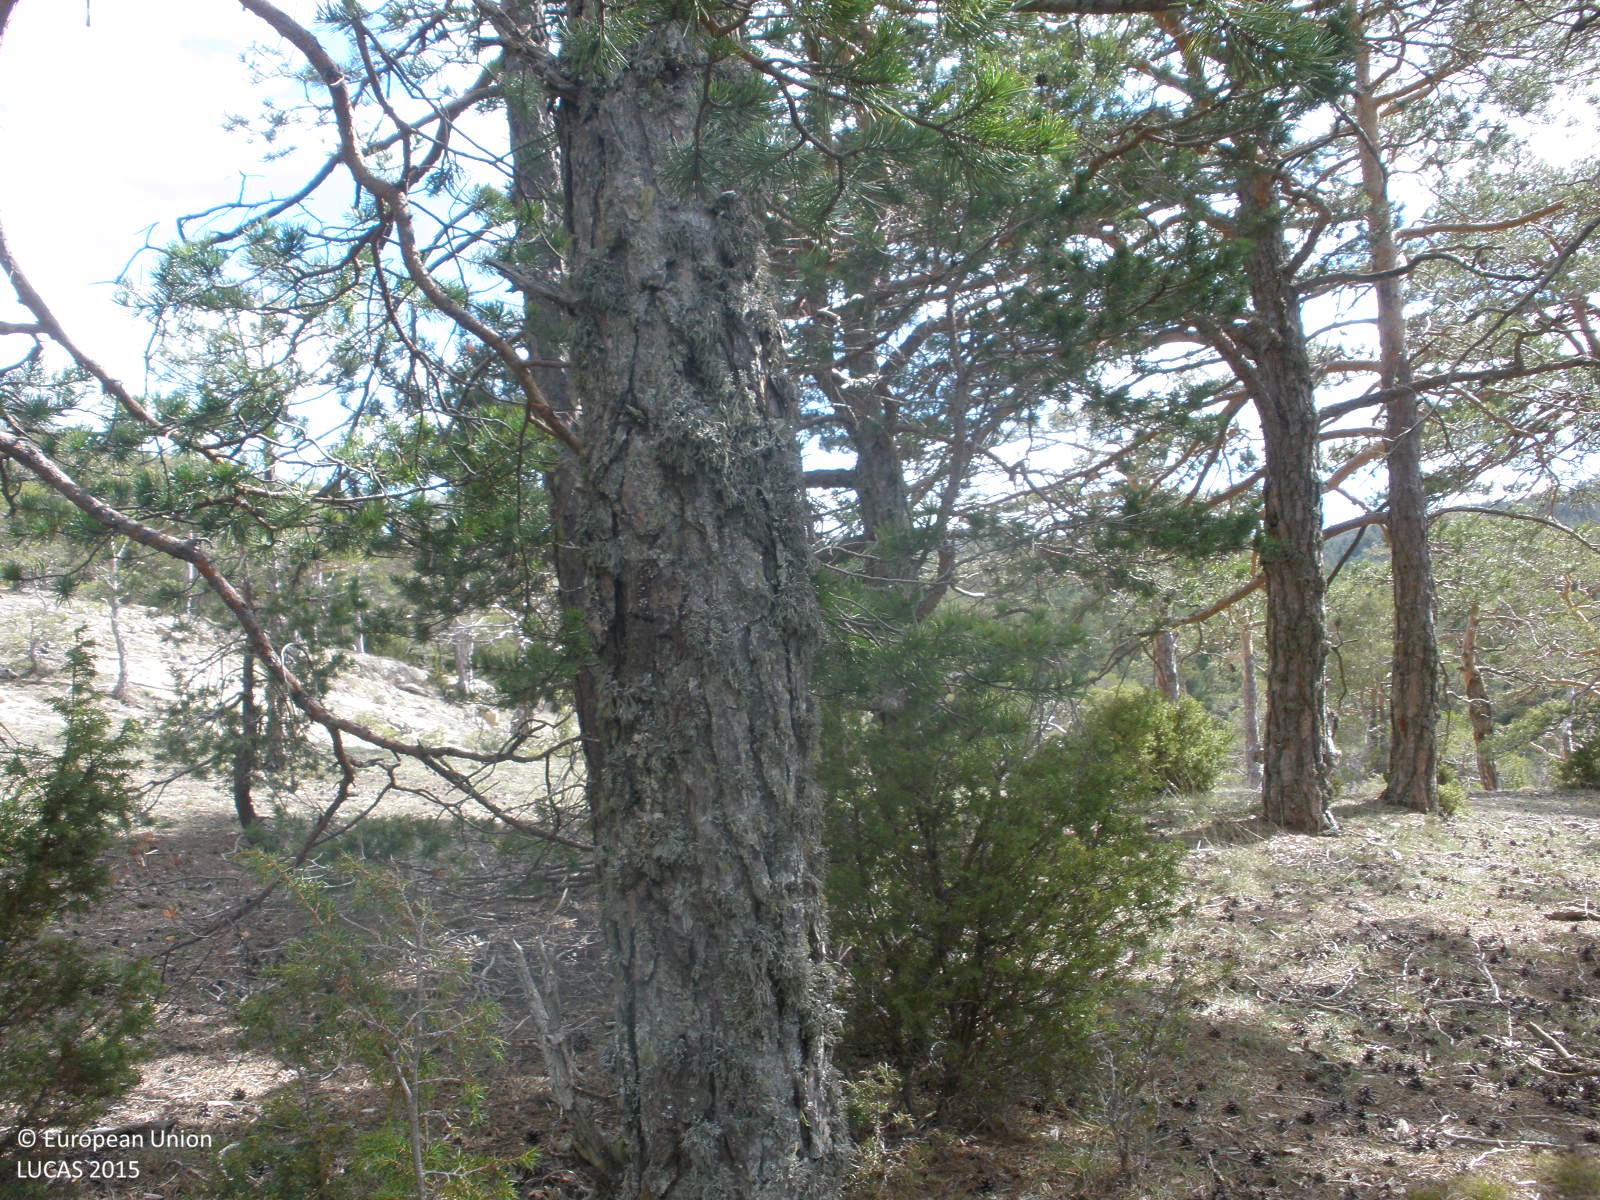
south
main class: Woodland
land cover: Pine dominated coniferous woodland
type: coniferous forest of the mediterranean region
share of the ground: 50 - 75 %
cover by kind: coniferous forest trees 70 %, herbaceous plants 20 %, shrubs 10 %
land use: Forestry
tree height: > 5 m
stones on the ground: < 10 %
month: April
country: ES
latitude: 40.3999
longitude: -0.7899
